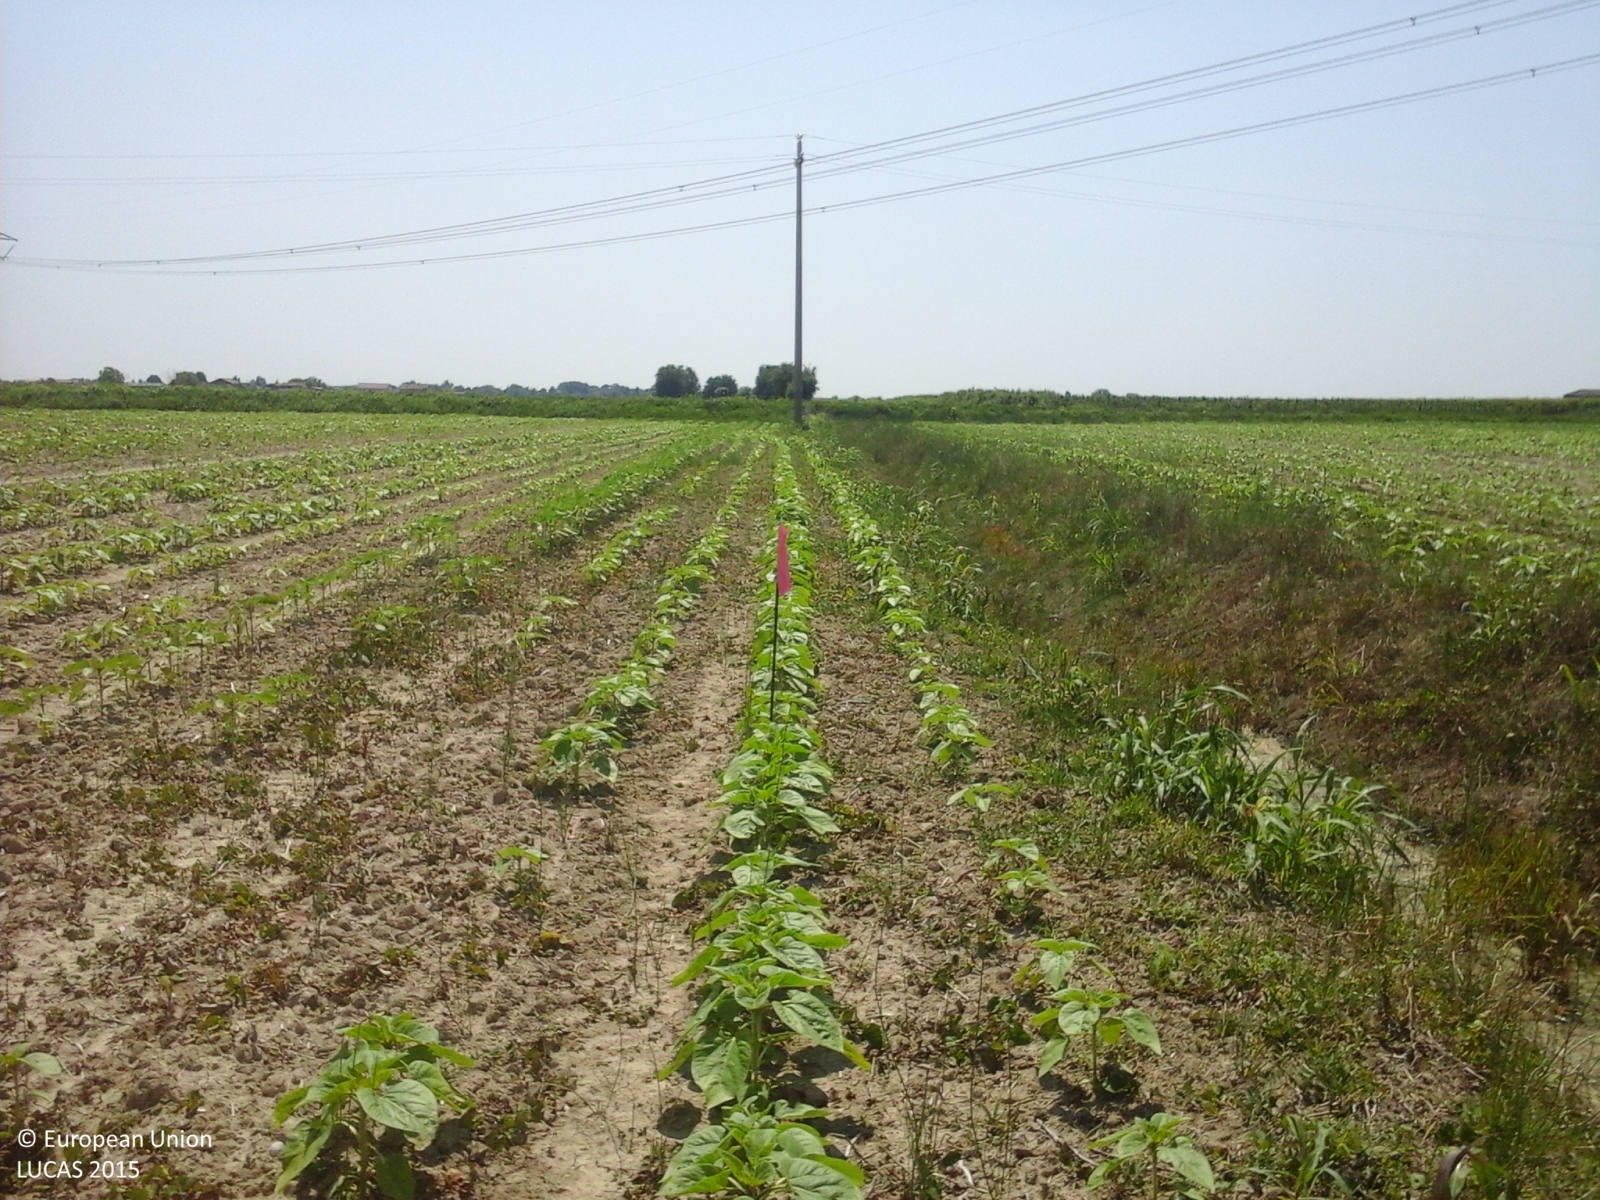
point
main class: Cropland
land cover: Sunflower
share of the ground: 10 - 25 %
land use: Agriculture (excluding fallow land and kitchen gardens)
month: May
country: IT
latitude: 44.8051
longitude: 11.7287
